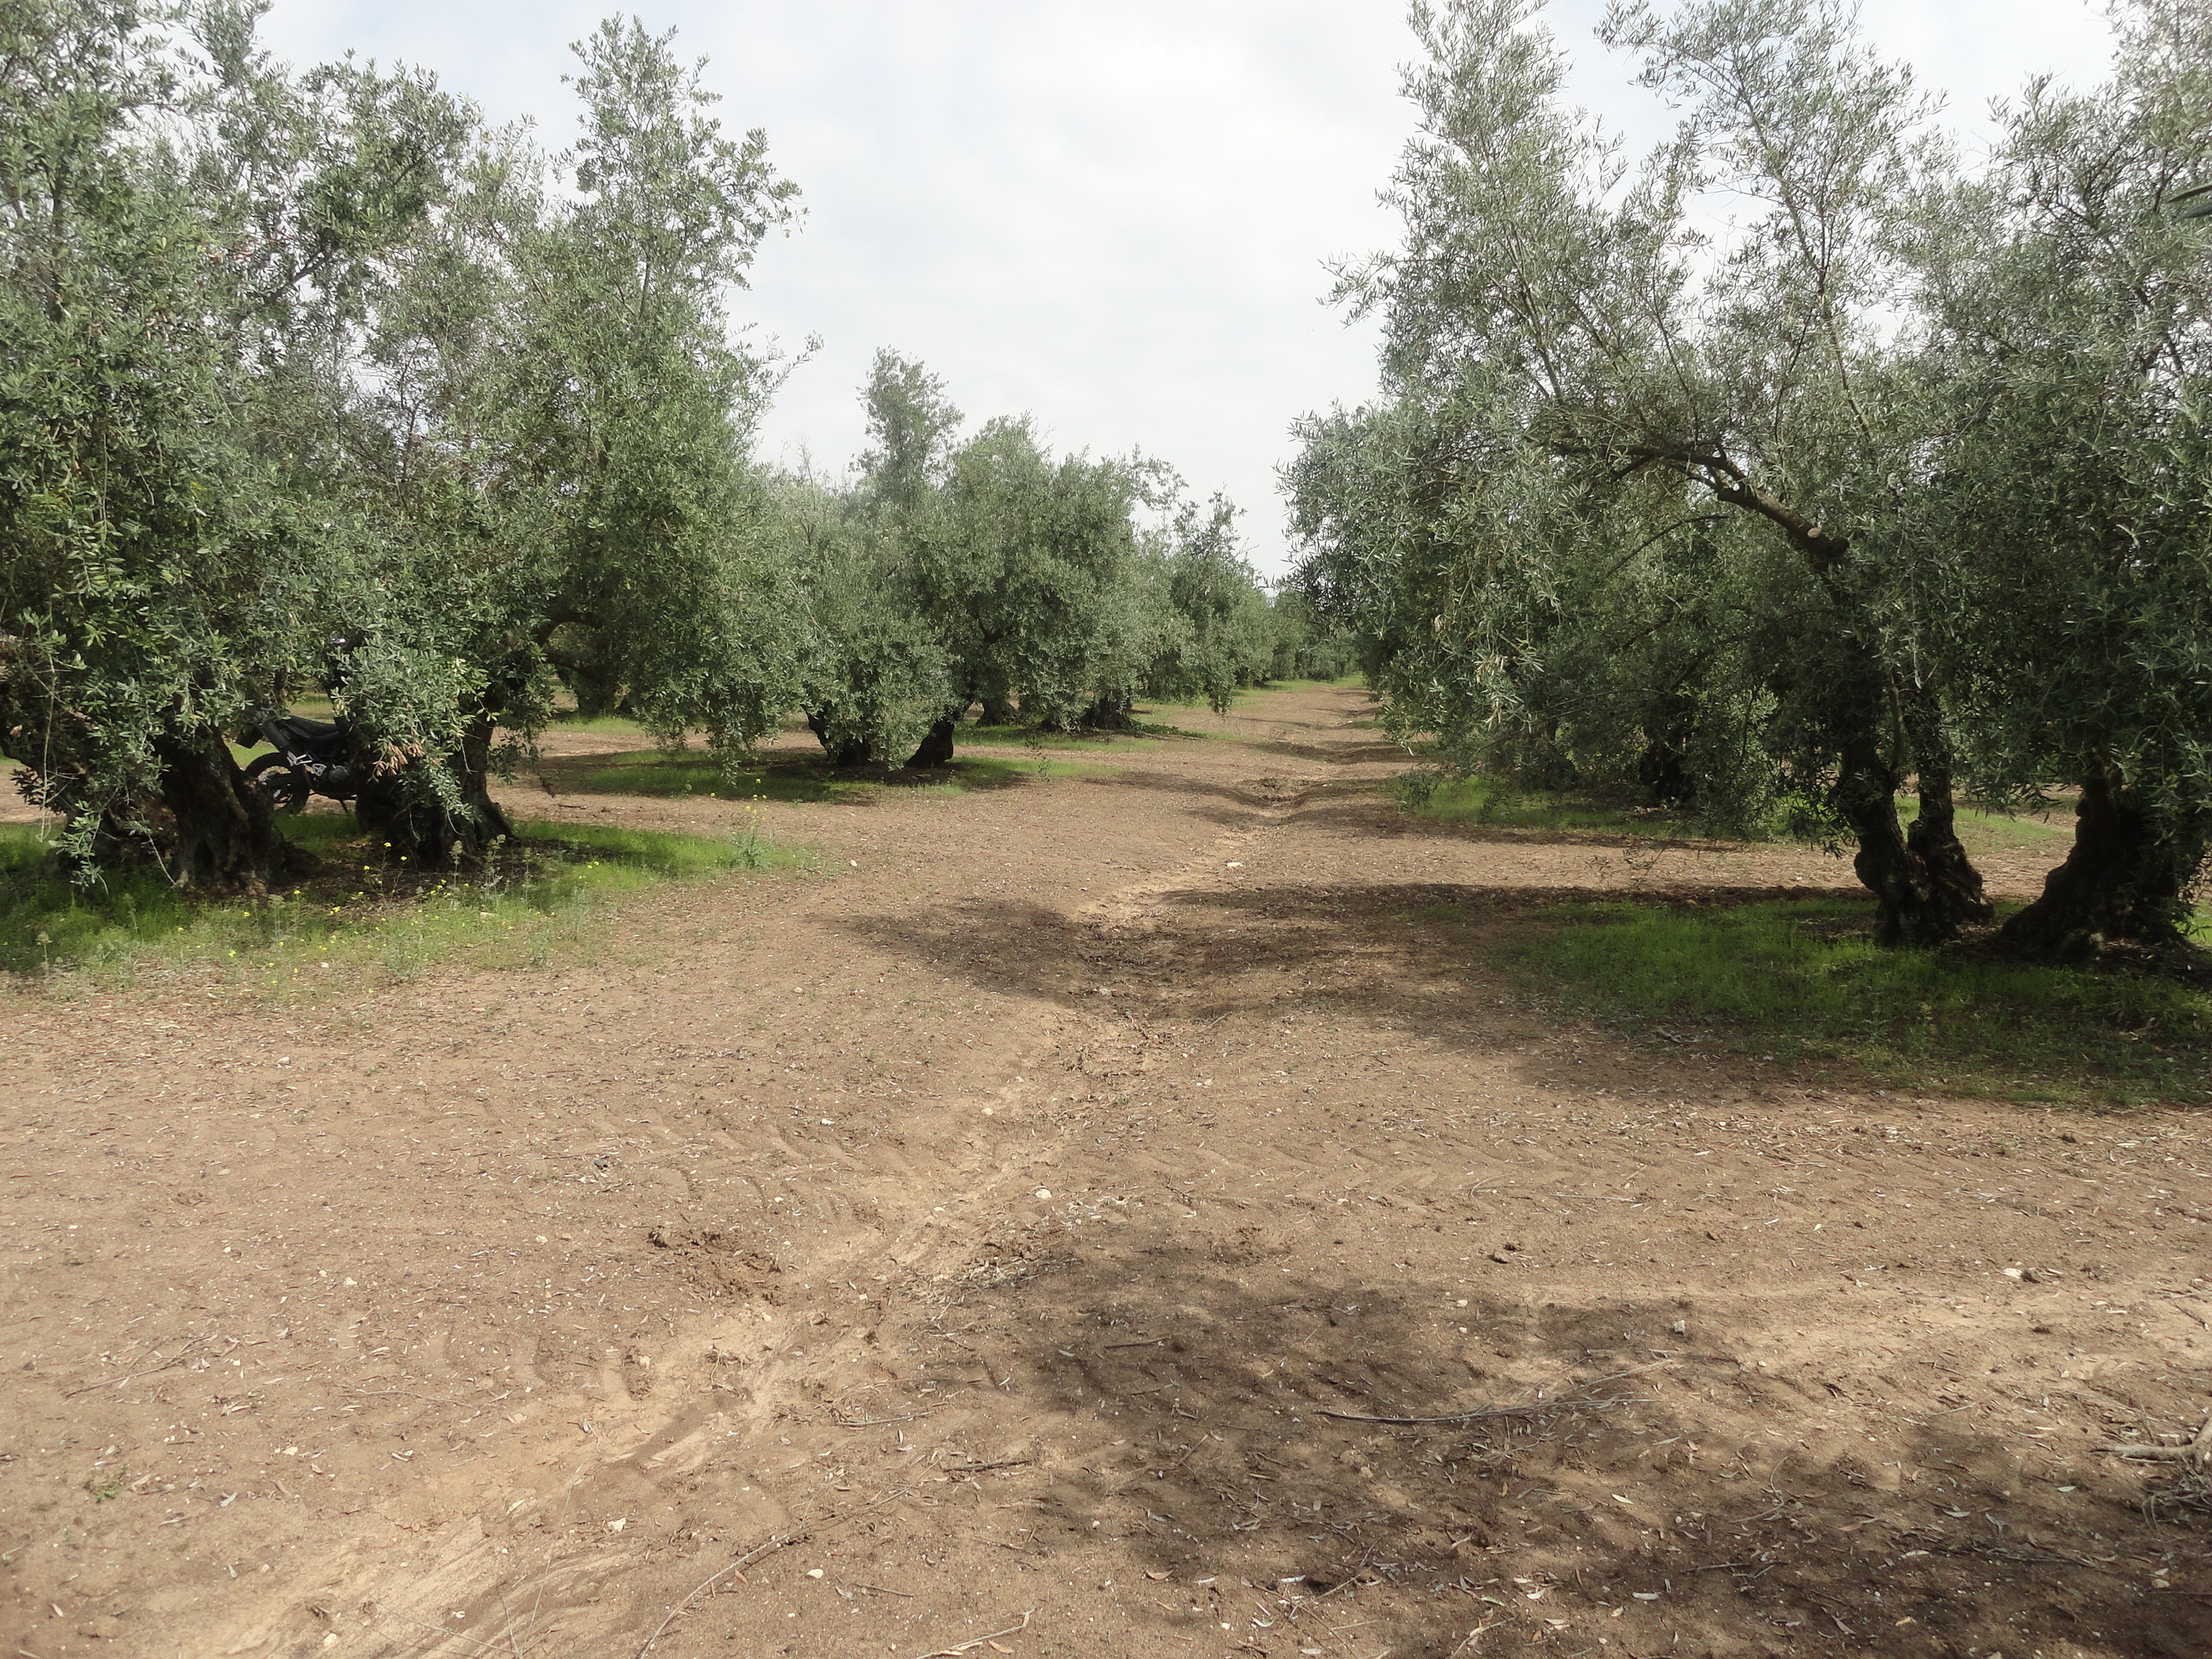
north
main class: Cropland
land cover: Olive groves
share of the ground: 50 - 75 %
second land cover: Spontaneously vegetated surfaces
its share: 10 - 25 %
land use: Agriculture (excluding fallow land and kitchen gardens)
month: April
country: ES
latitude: 37.5347
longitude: -4.5934
